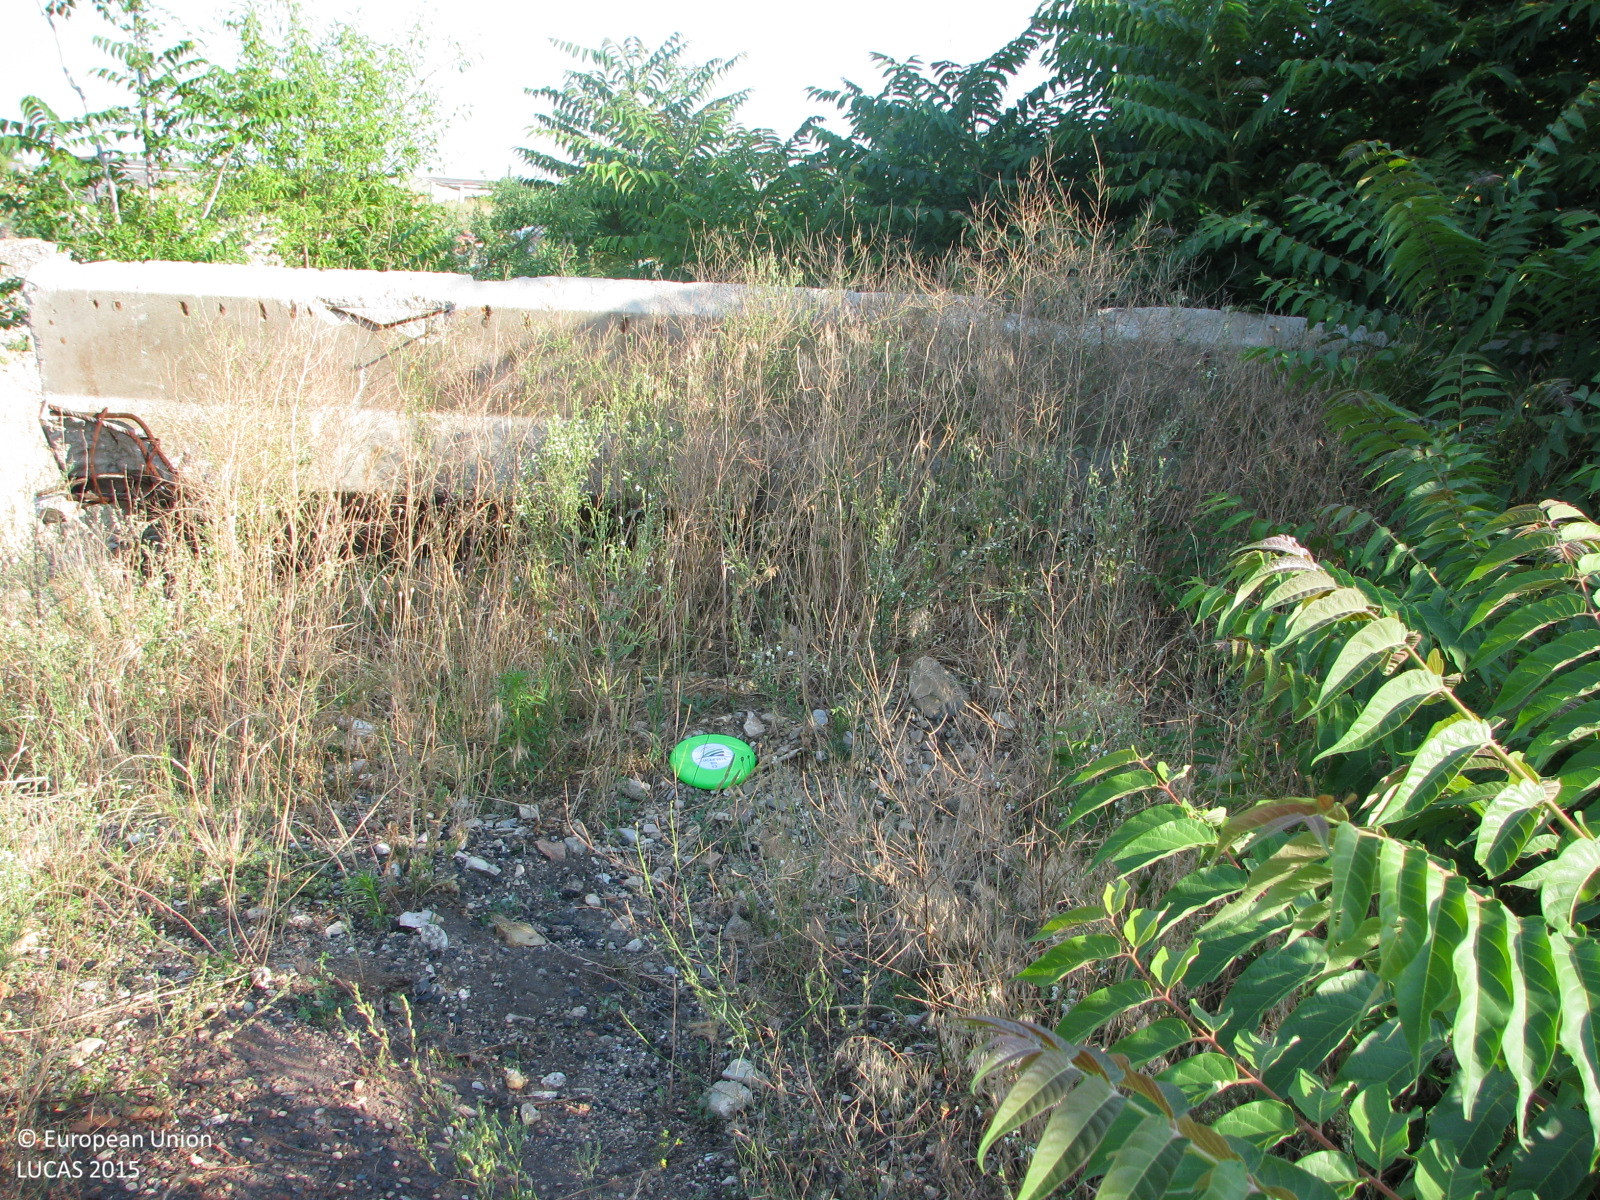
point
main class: Grassland
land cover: Grassland with sparse tree/shrub cover
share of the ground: > 75 %
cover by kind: herbaceous plants 90 %, broadleaved forest trees 5 %, shrubs 5 %
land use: Abandoned areas
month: June
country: BG
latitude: 42.6607
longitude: 26.3283
